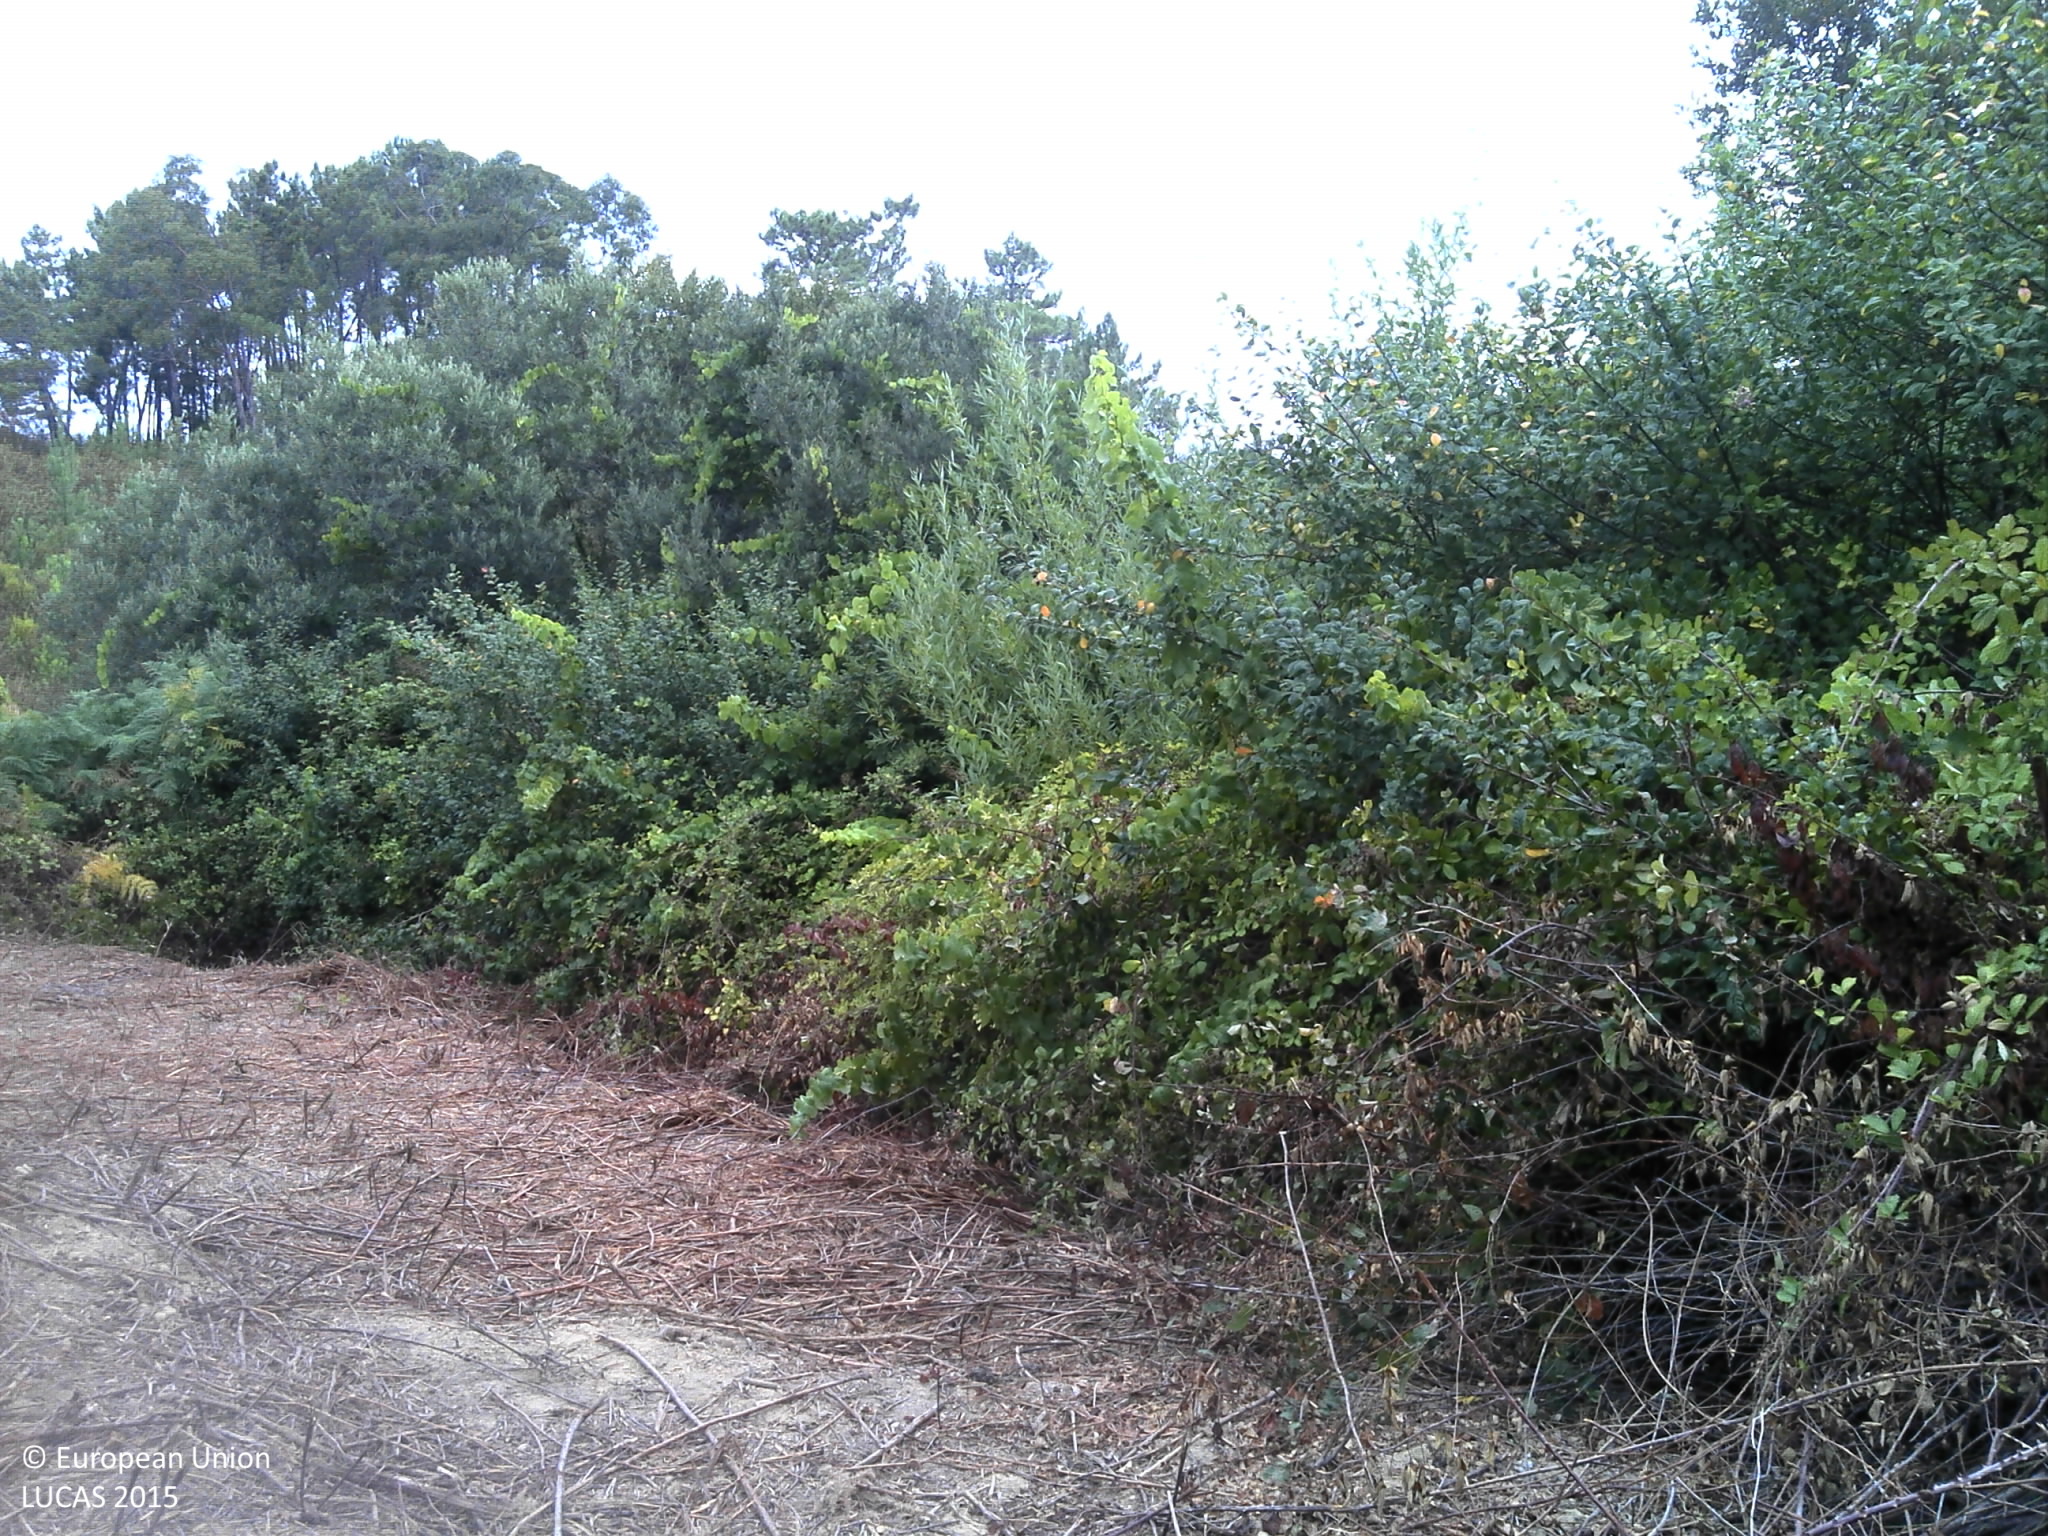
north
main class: Shrubland
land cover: Shrubland without tree cover
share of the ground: > 75 %
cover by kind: shrubs 80 %, unconsolidated bare surface 20 %
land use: Forestry
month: July
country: PT
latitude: 37.3850
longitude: -8.7508
